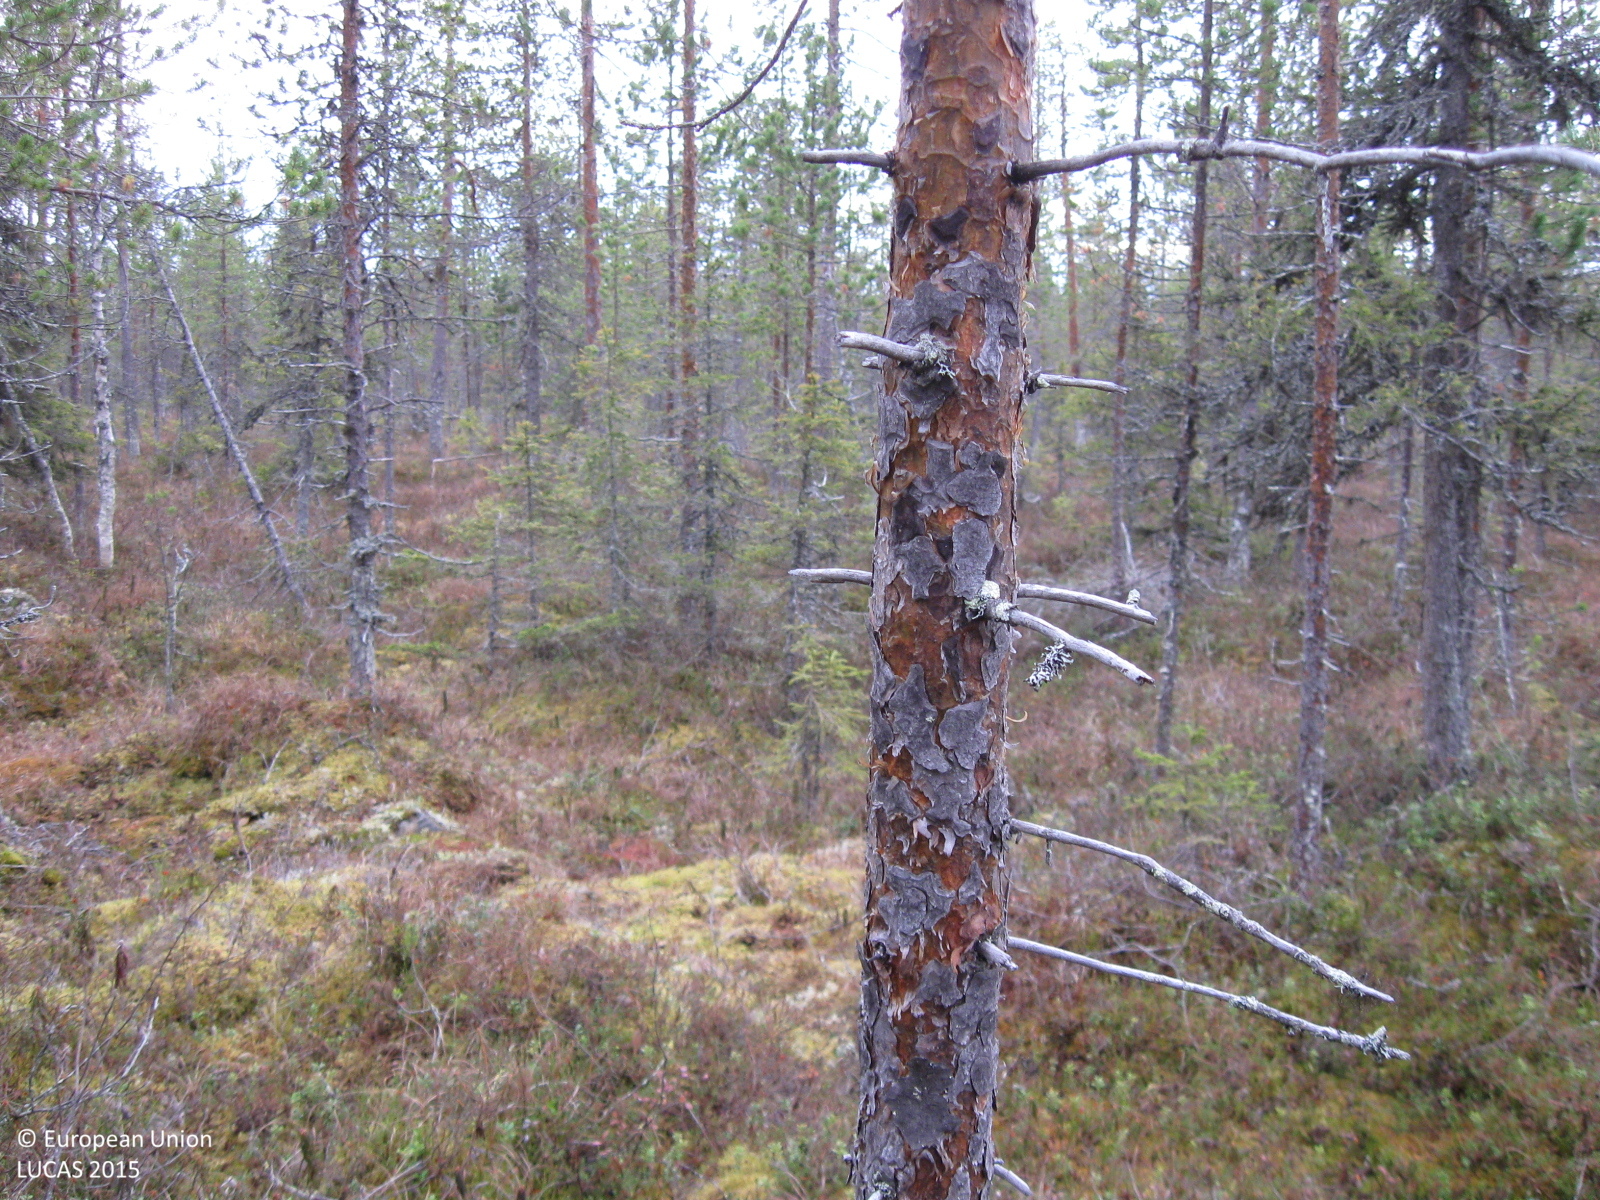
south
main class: Woodland
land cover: Pine dominated coniferous woodland
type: mire and swamp forests
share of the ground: 50 - 75 %
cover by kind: coniferous forest trees 70 %, shrubs 15 %, lichens and mosses 10 %, herbaceous plants 5 %
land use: Forestry
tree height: > 5 m
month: October
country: SE
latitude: 66.5915
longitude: 21.8517
